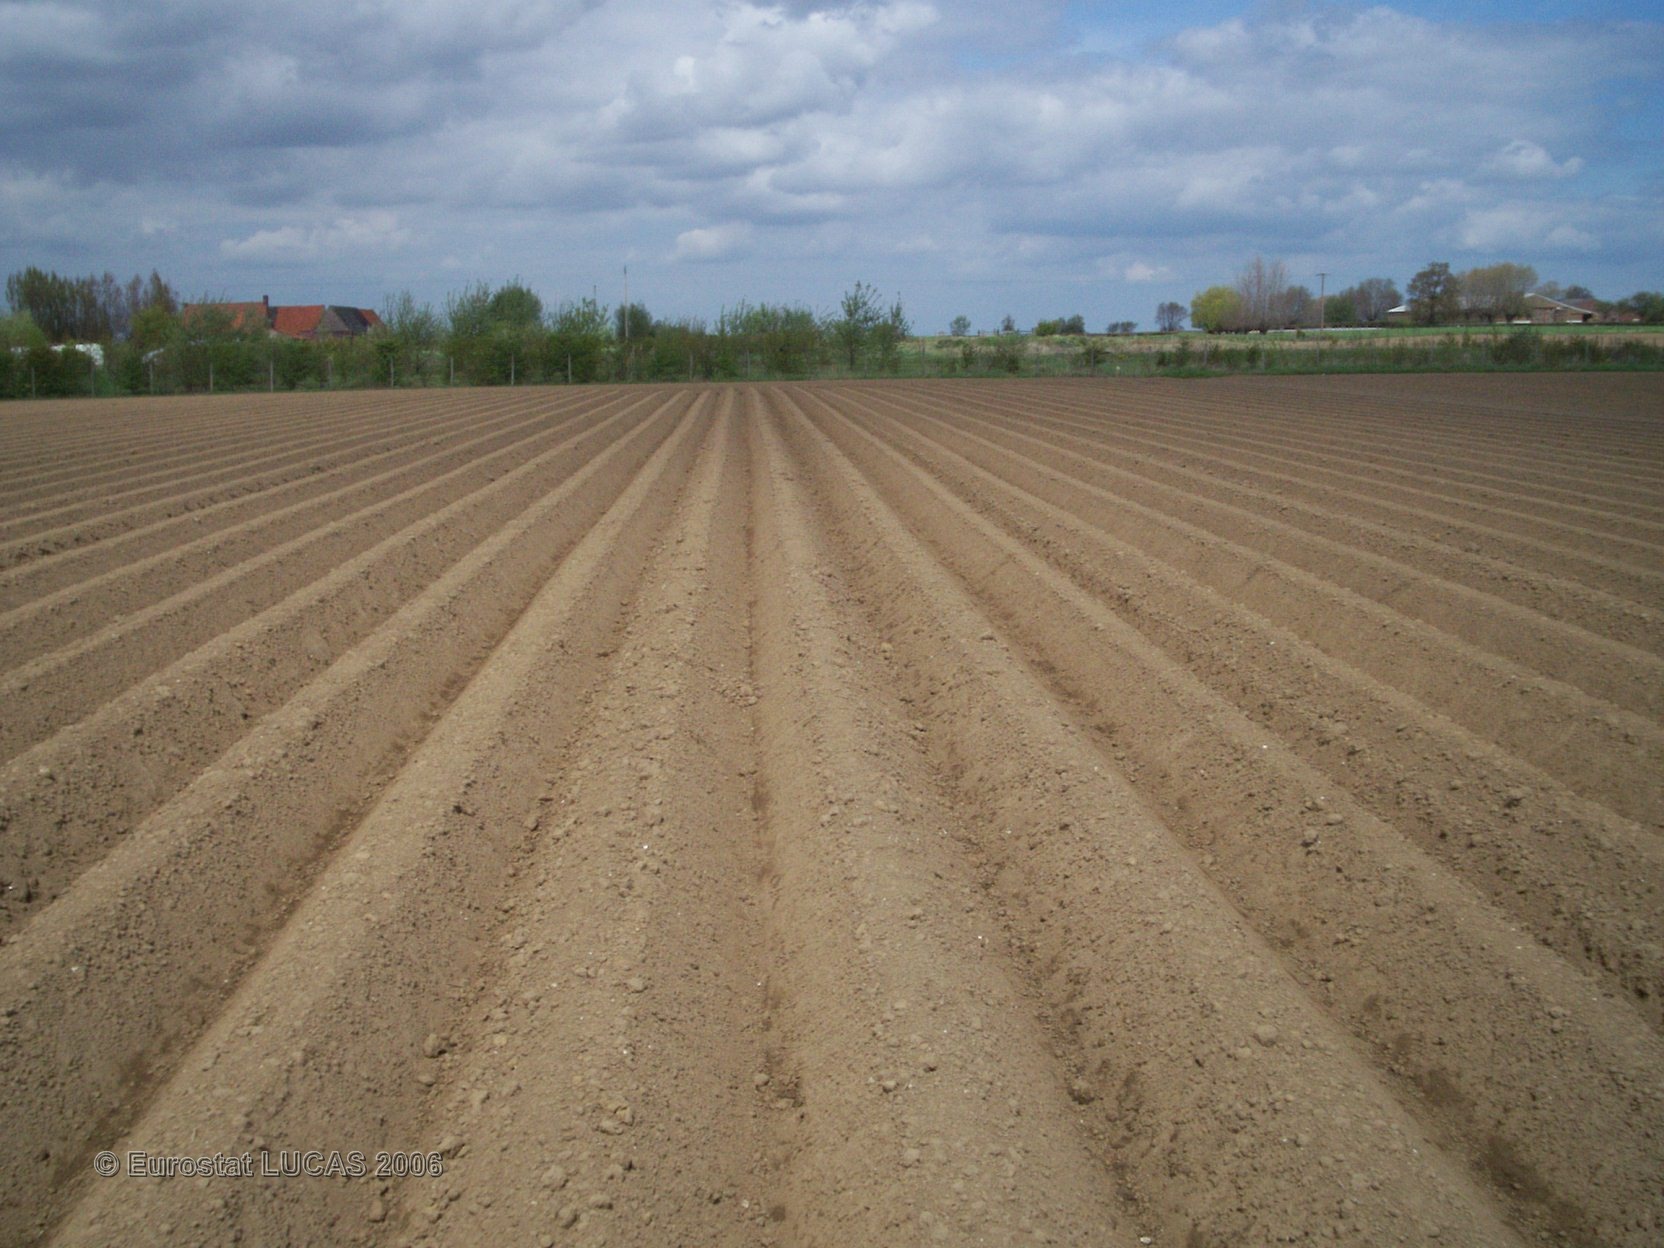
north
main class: Cropland
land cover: Potatoes
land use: Agriculture (excluding fallow land and kitchen gardens)
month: May
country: FR
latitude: 50.9154
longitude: 2.5485
